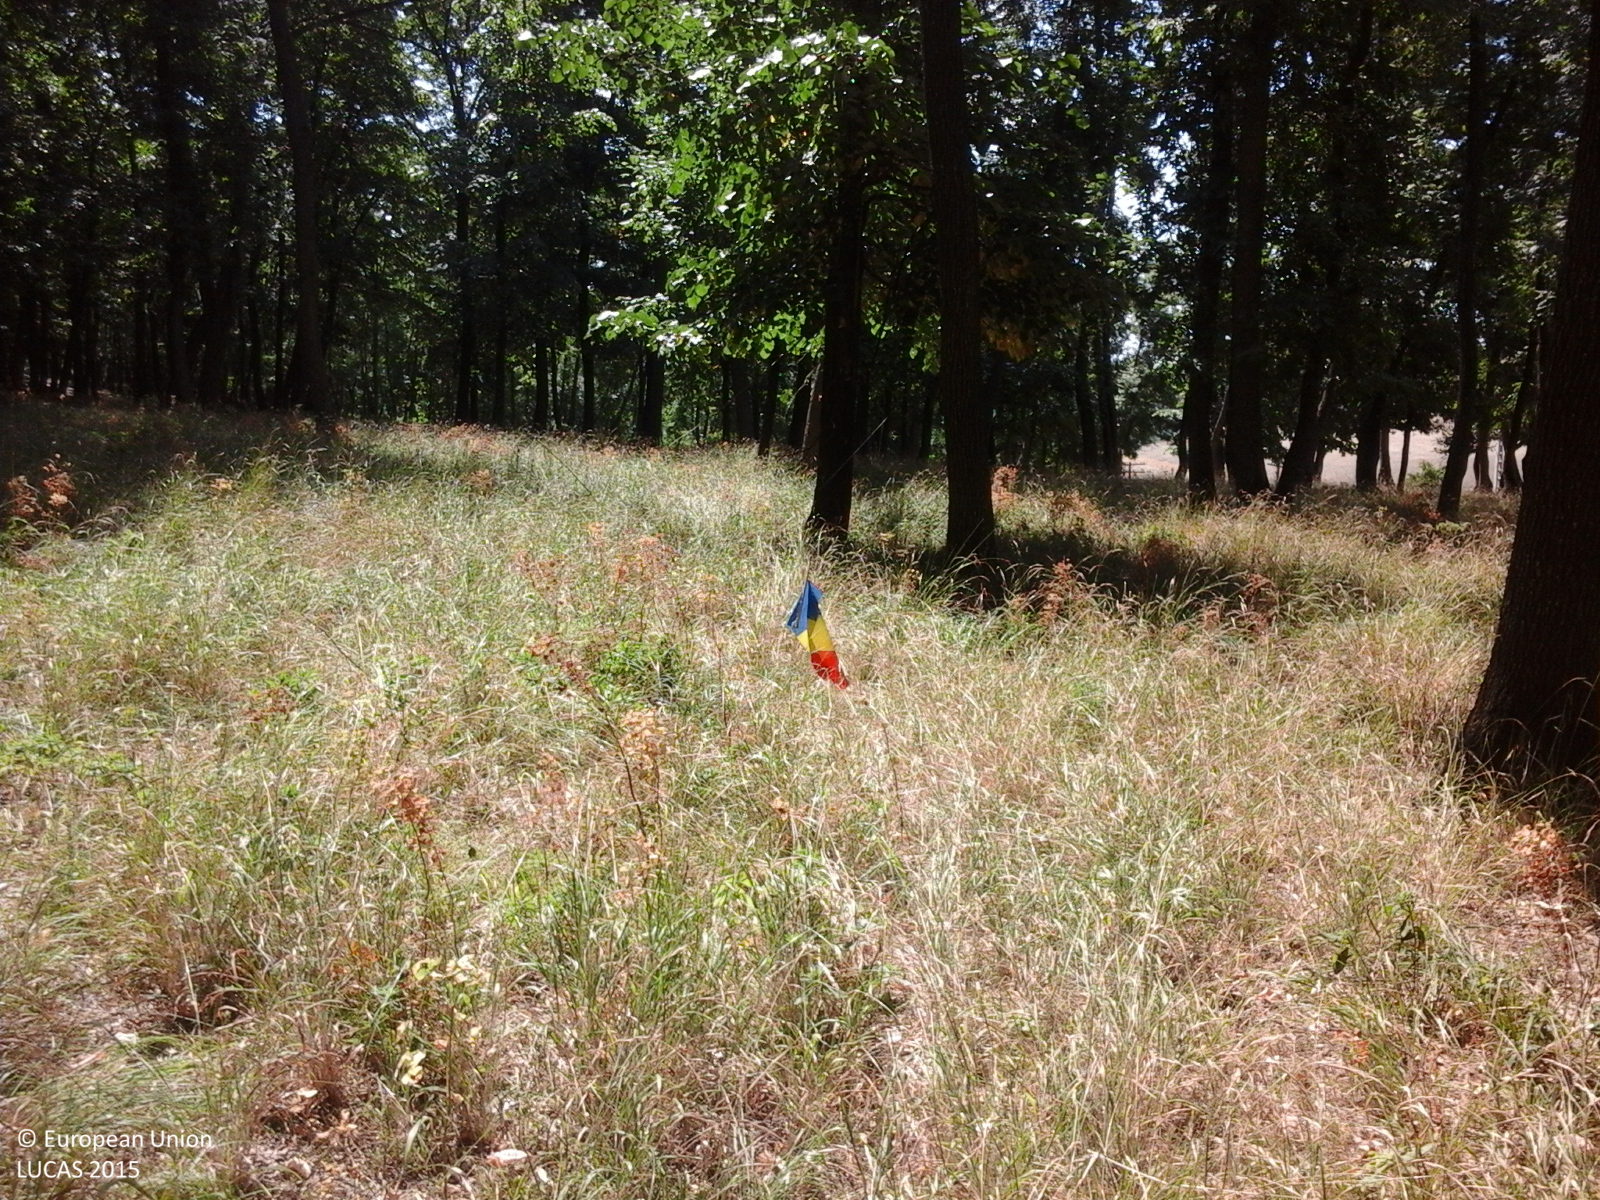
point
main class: Woodland
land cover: Broadleaved woodland
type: acidophilous oak and oak-birch forest
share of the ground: > 75 %
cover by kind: broadleaved forest trees 100 %
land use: Forestry
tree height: > 5 m
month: July
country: RO
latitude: 46.1222
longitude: 27.8608
